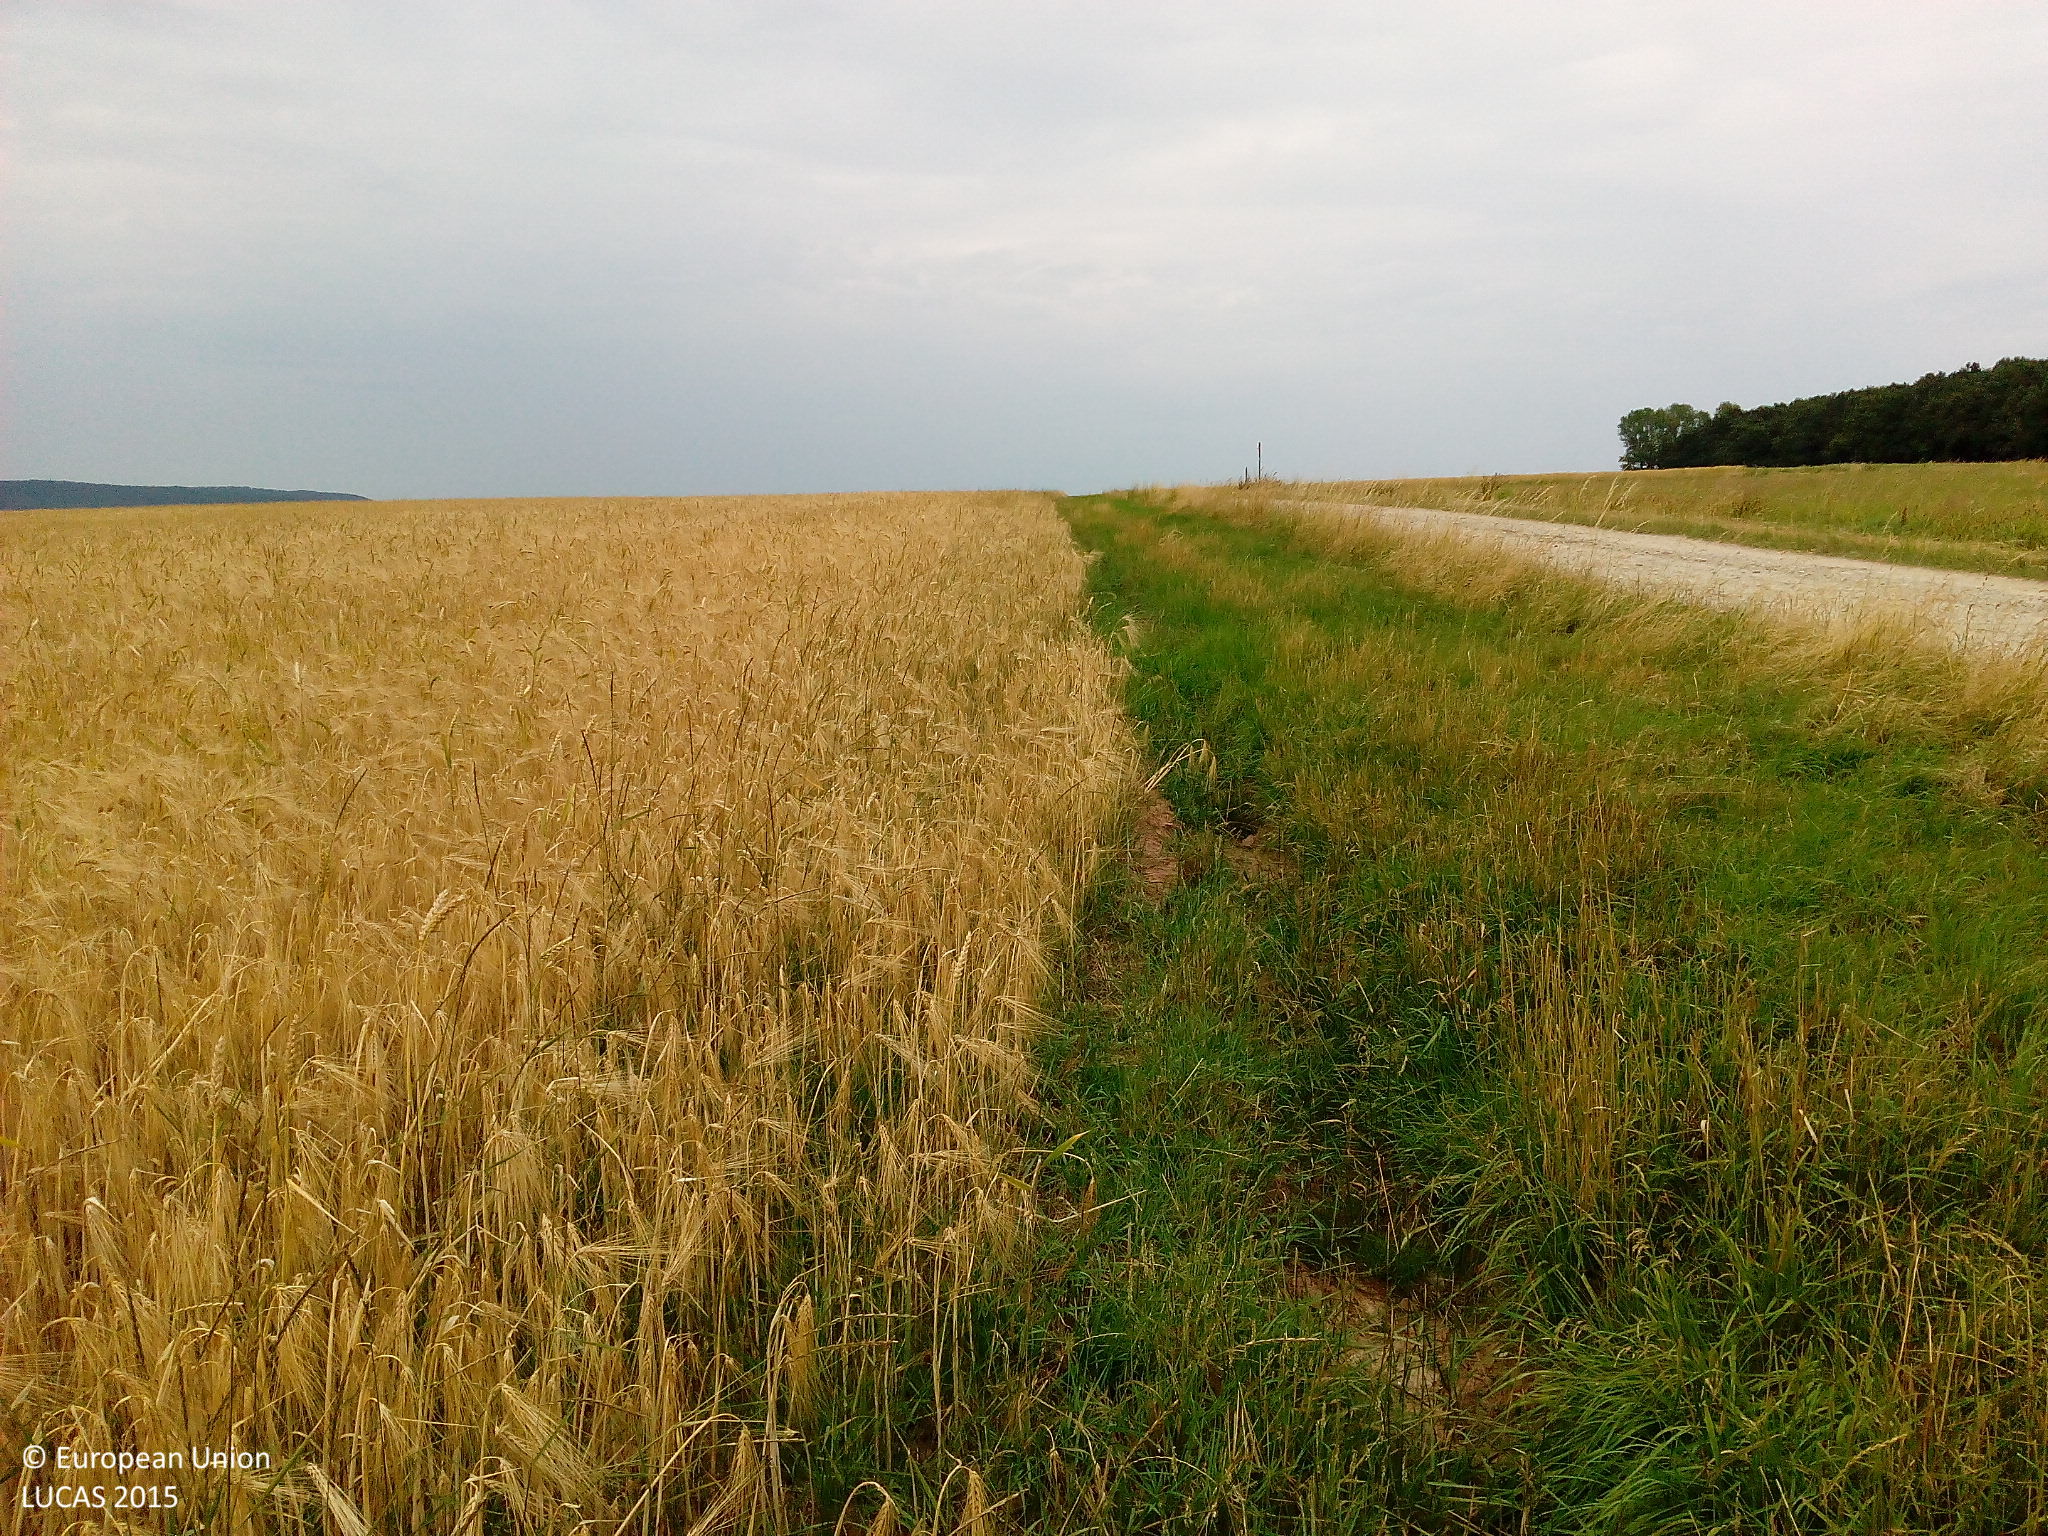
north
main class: Cropland
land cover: Barley
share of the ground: > 75 %
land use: Agriculture (excluding fallow land and kitchen gardens)
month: July
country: DE
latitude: 50.7955
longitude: 9.9291
